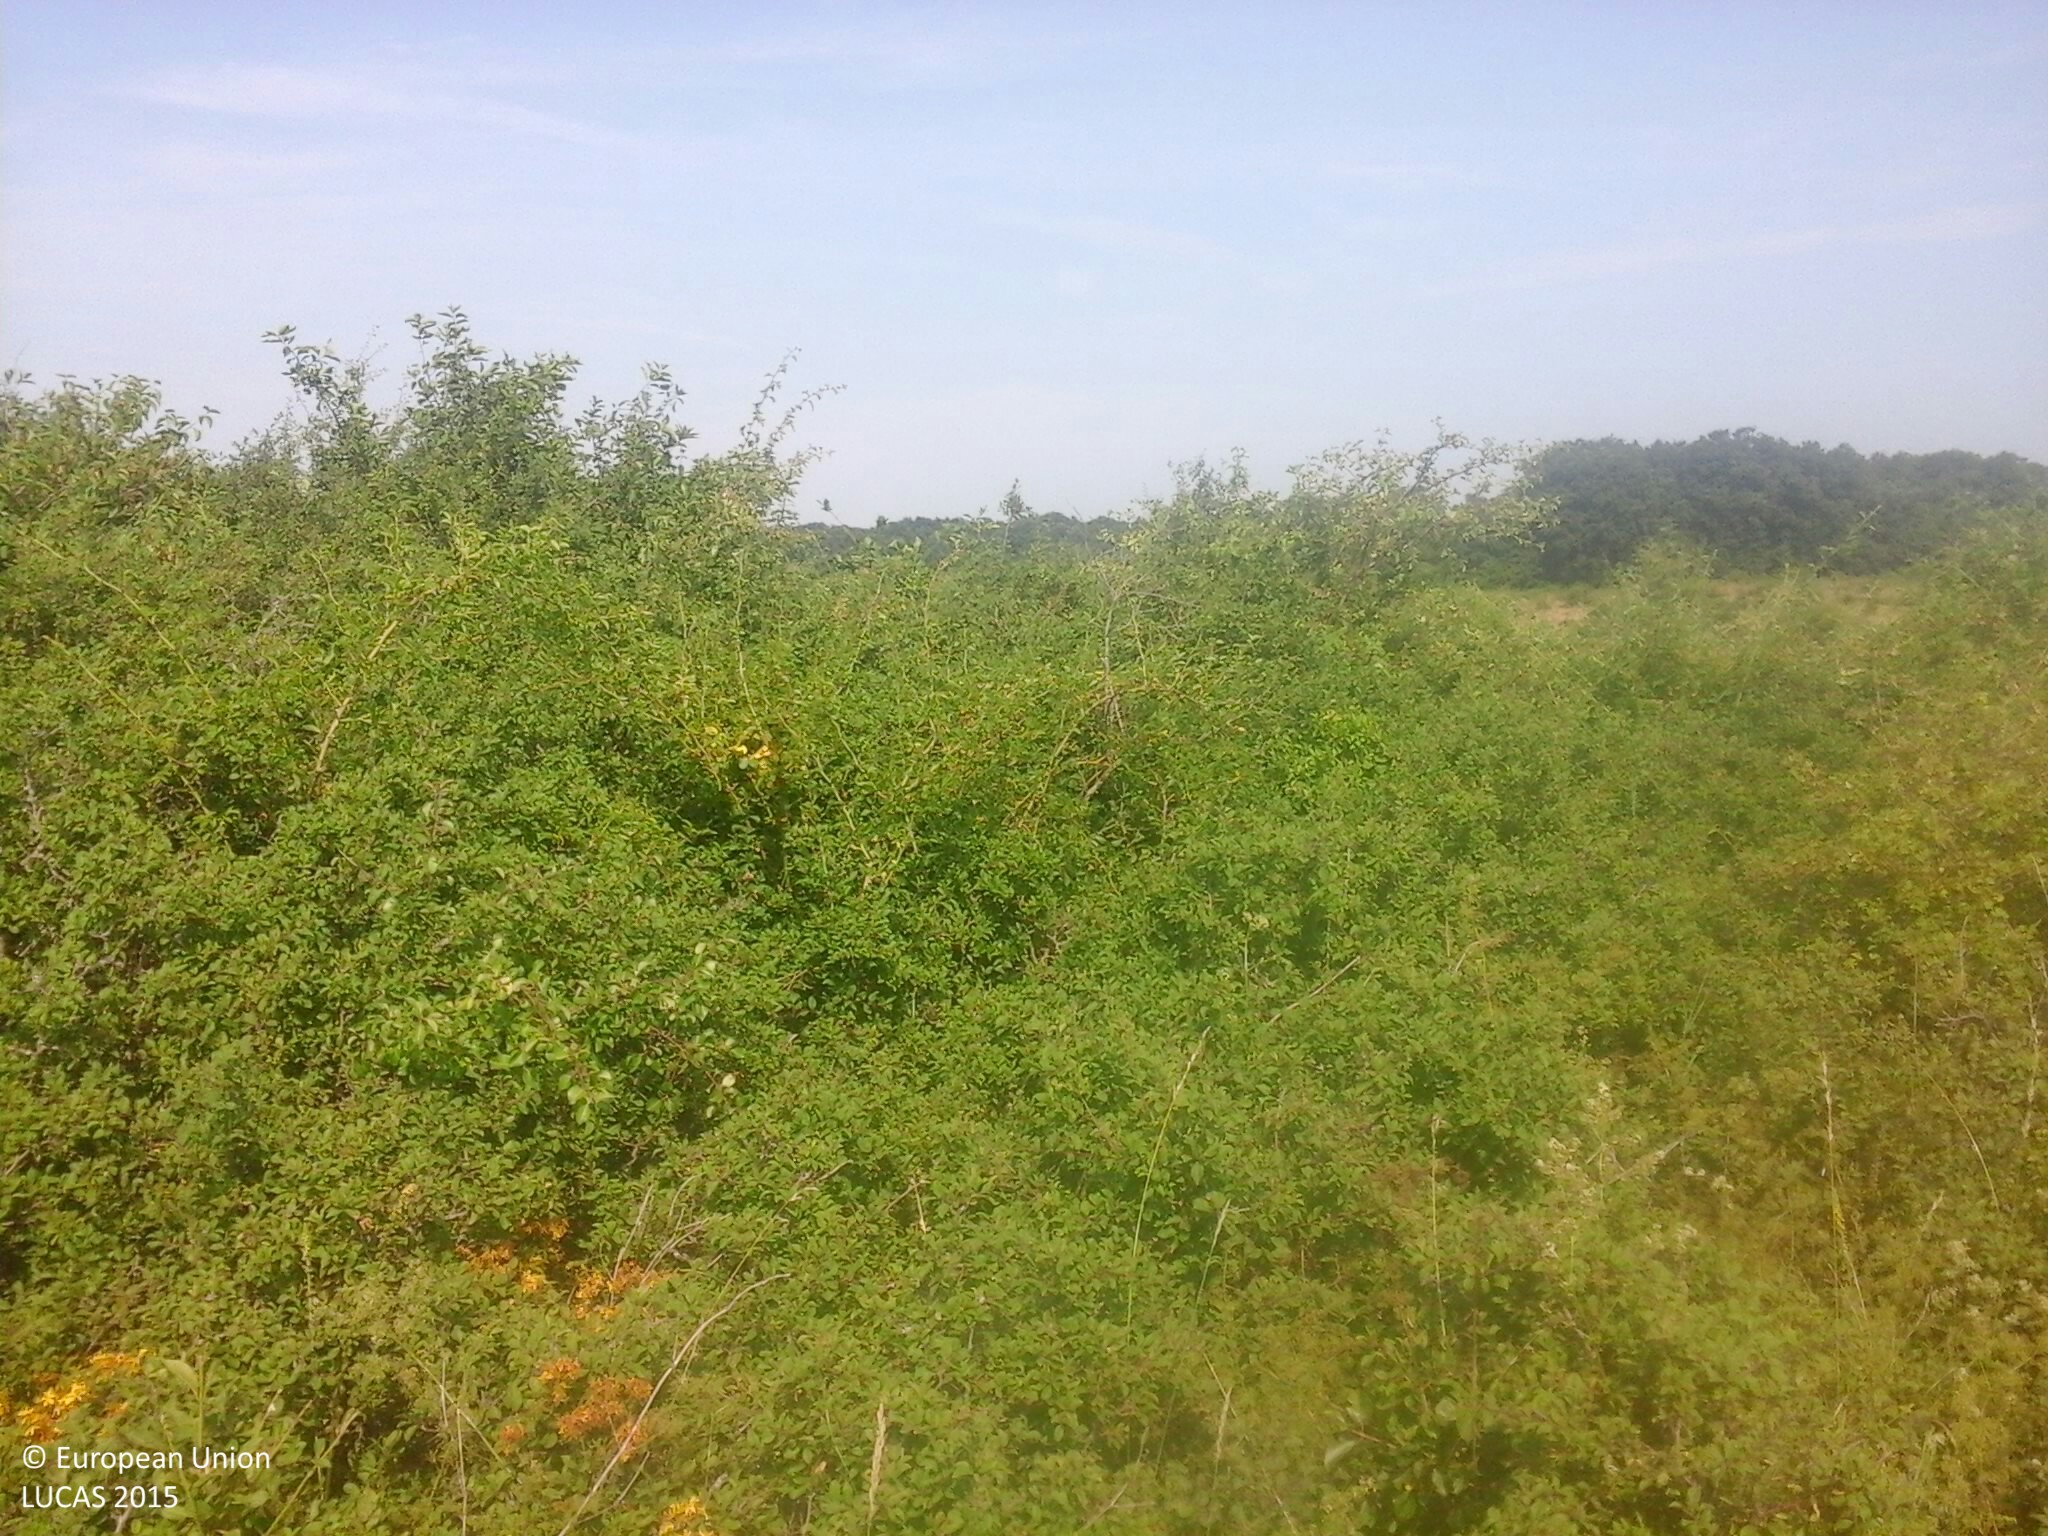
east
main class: Shrubland
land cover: Shrubland without tree cover
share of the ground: > 75 %
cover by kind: shrubs 95 %, herbaceous plants 5 %
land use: Semi-natural and natural areas not in use
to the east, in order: Shrubland without tree cover; Grassland with sparse tree/shrub cover
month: July
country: HU
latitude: 46.9920
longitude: 17.7526
